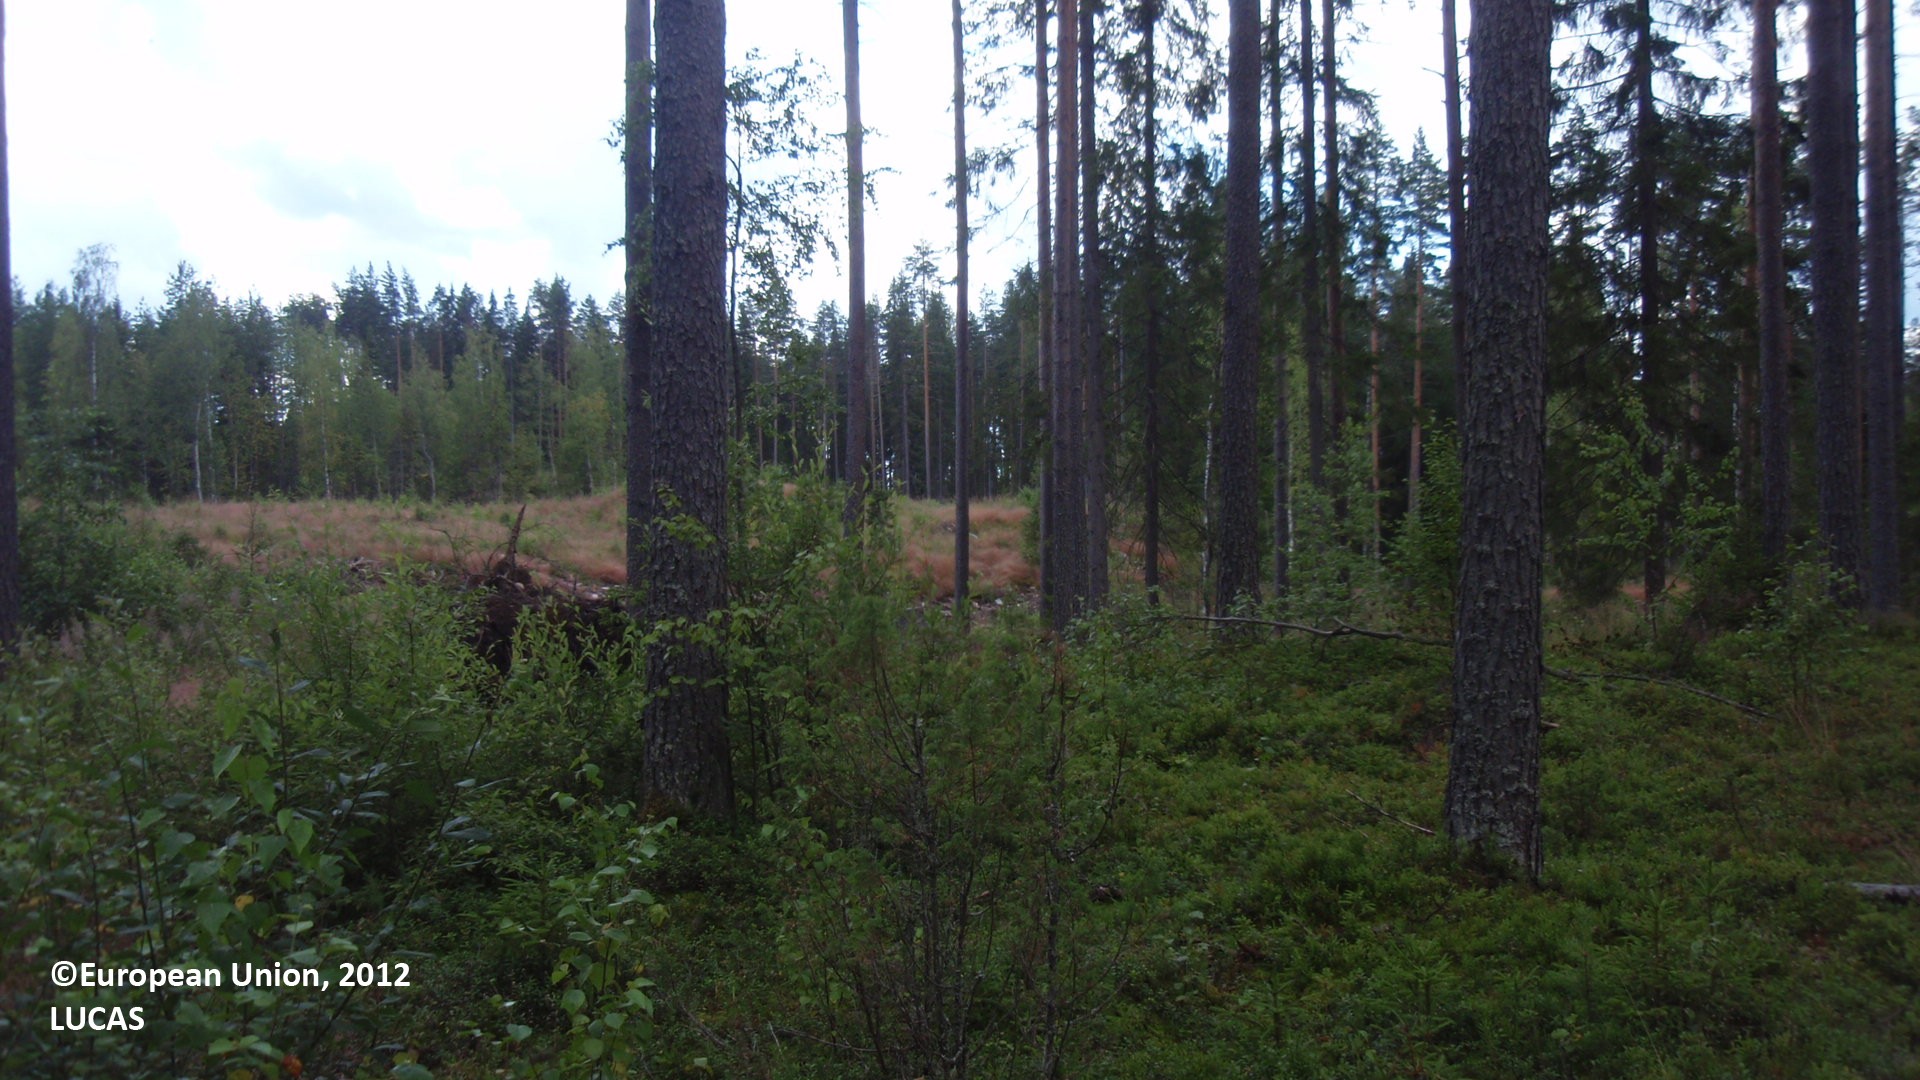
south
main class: Woodland
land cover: Pine dominated mixed woodland
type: boreal forest
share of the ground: 25 - 50 %
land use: Forestry
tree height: > 5 m
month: July
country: FI
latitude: 61.4217
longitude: 28.9895
